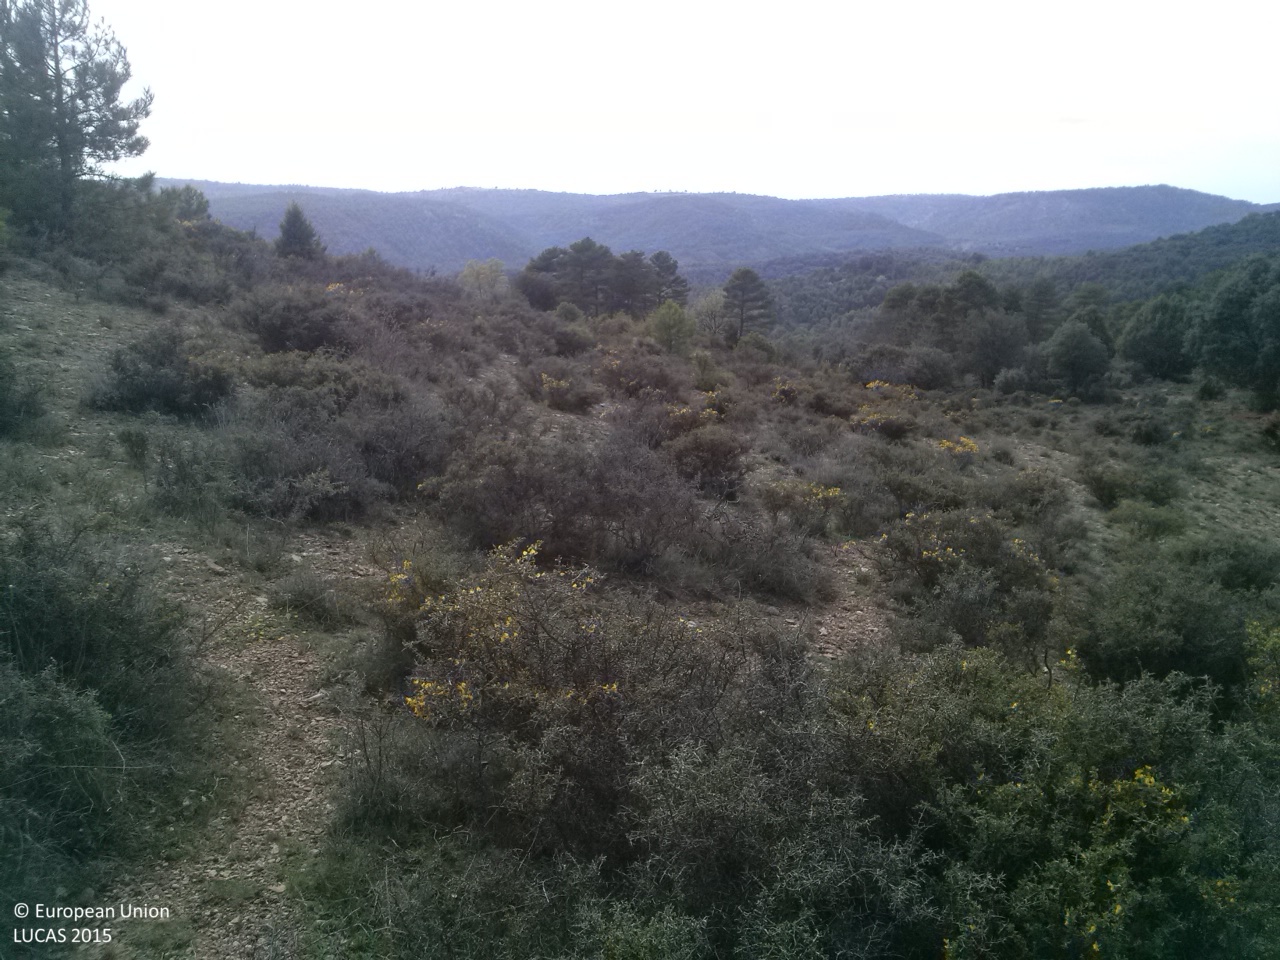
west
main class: Shrubland
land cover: Shrubland without tree cover
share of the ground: 50 - 75 %
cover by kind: shrubs 60 %, herbaceous plants 30 %, unconsolidated bare surface 10 %
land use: Agriculture (excluding fallow land and kitchen gardens)
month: April
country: ES
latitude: 40.1237
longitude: -1.7594
